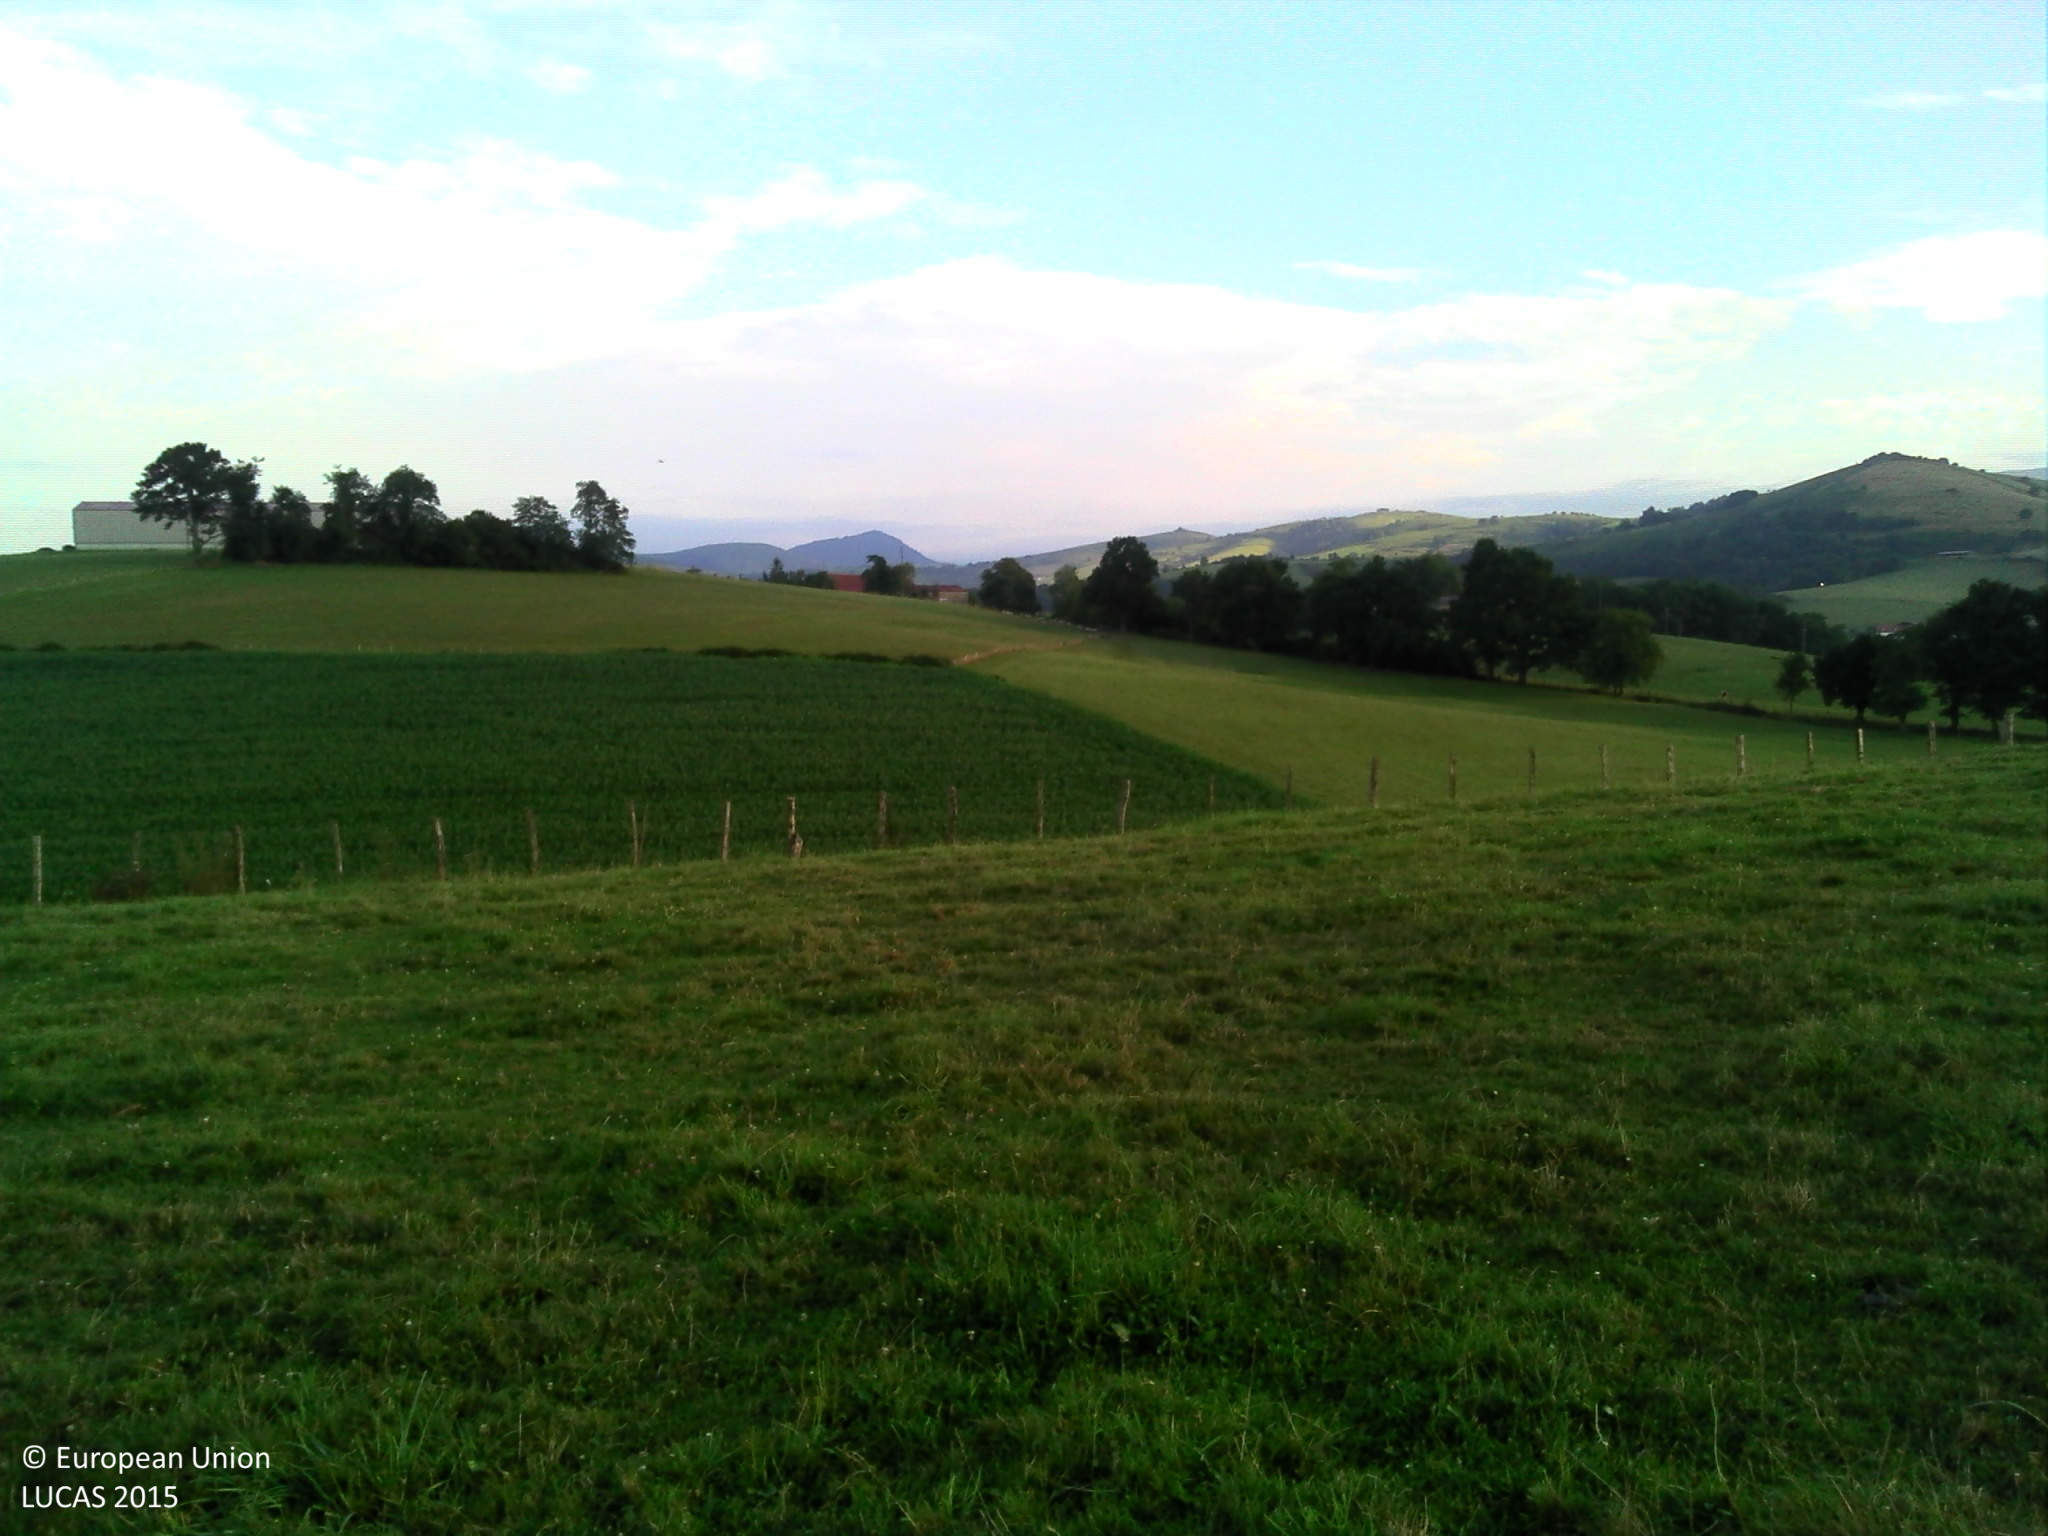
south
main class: Grassland
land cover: Grassland without tree/shrub cover
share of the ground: > 75 %
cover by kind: herbaceous plants 100 %
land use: Agriculture (excluding fallow land and kitchen gardens)
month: August
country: FR
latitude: 43.2649
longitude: -1.2375
